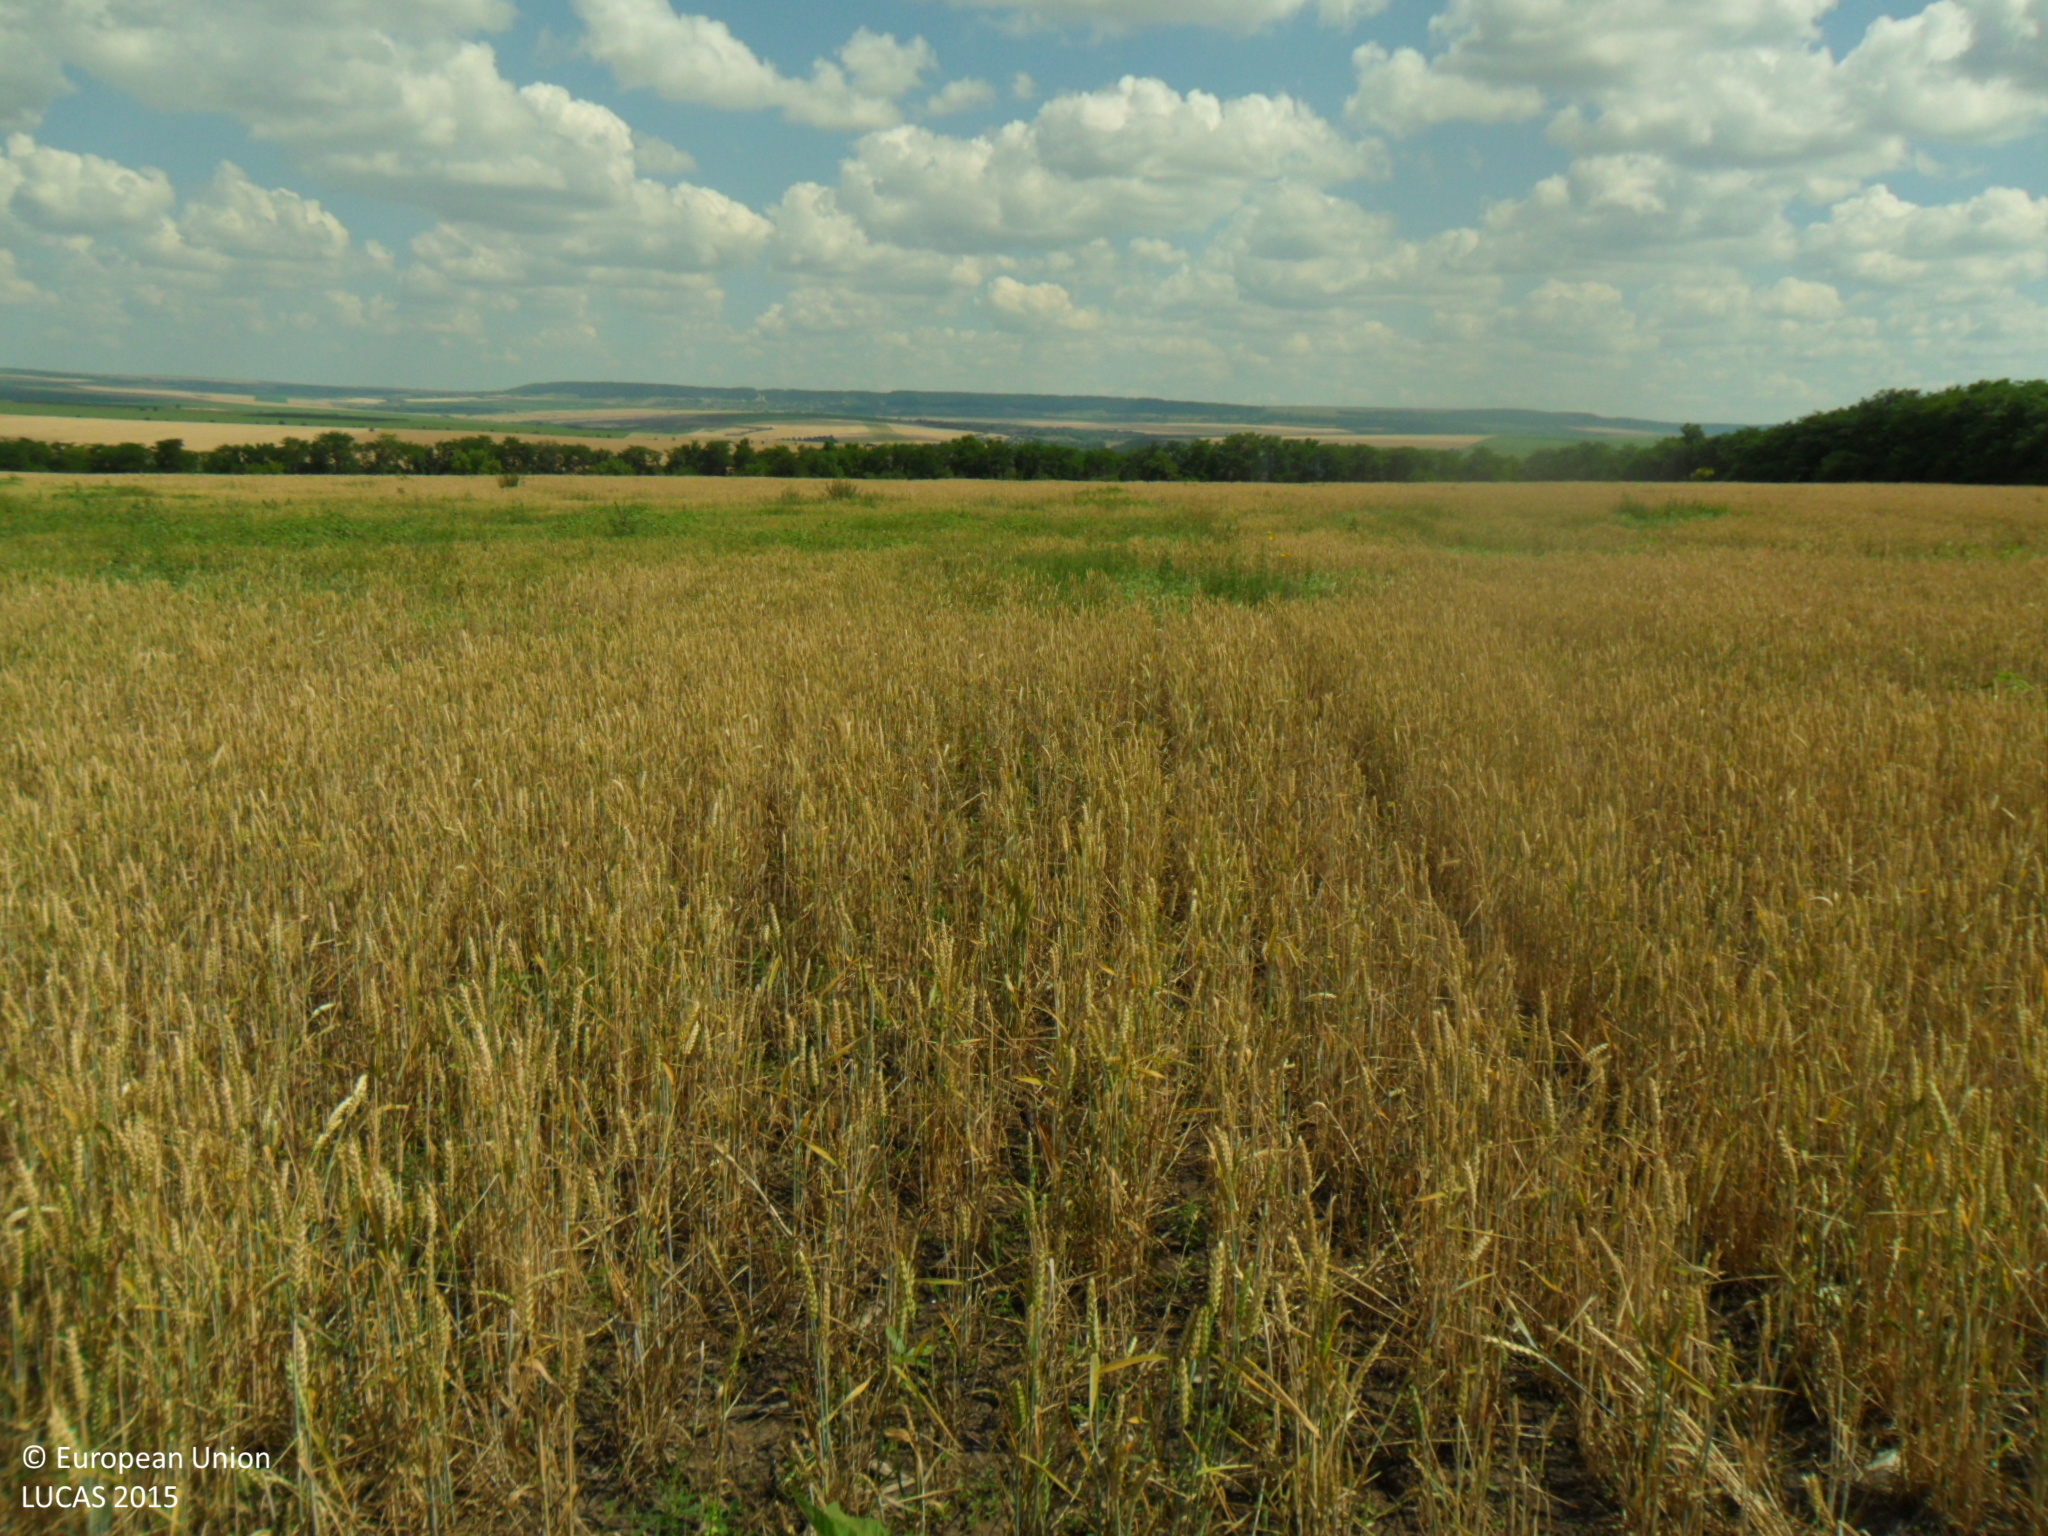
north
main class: Cropland
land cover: Common wheat
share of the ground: > 75 %
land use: Agriculture (excluding fallow land and kitchen gardens)
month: June
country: BG
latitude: 43.3573
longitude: 27.0072
